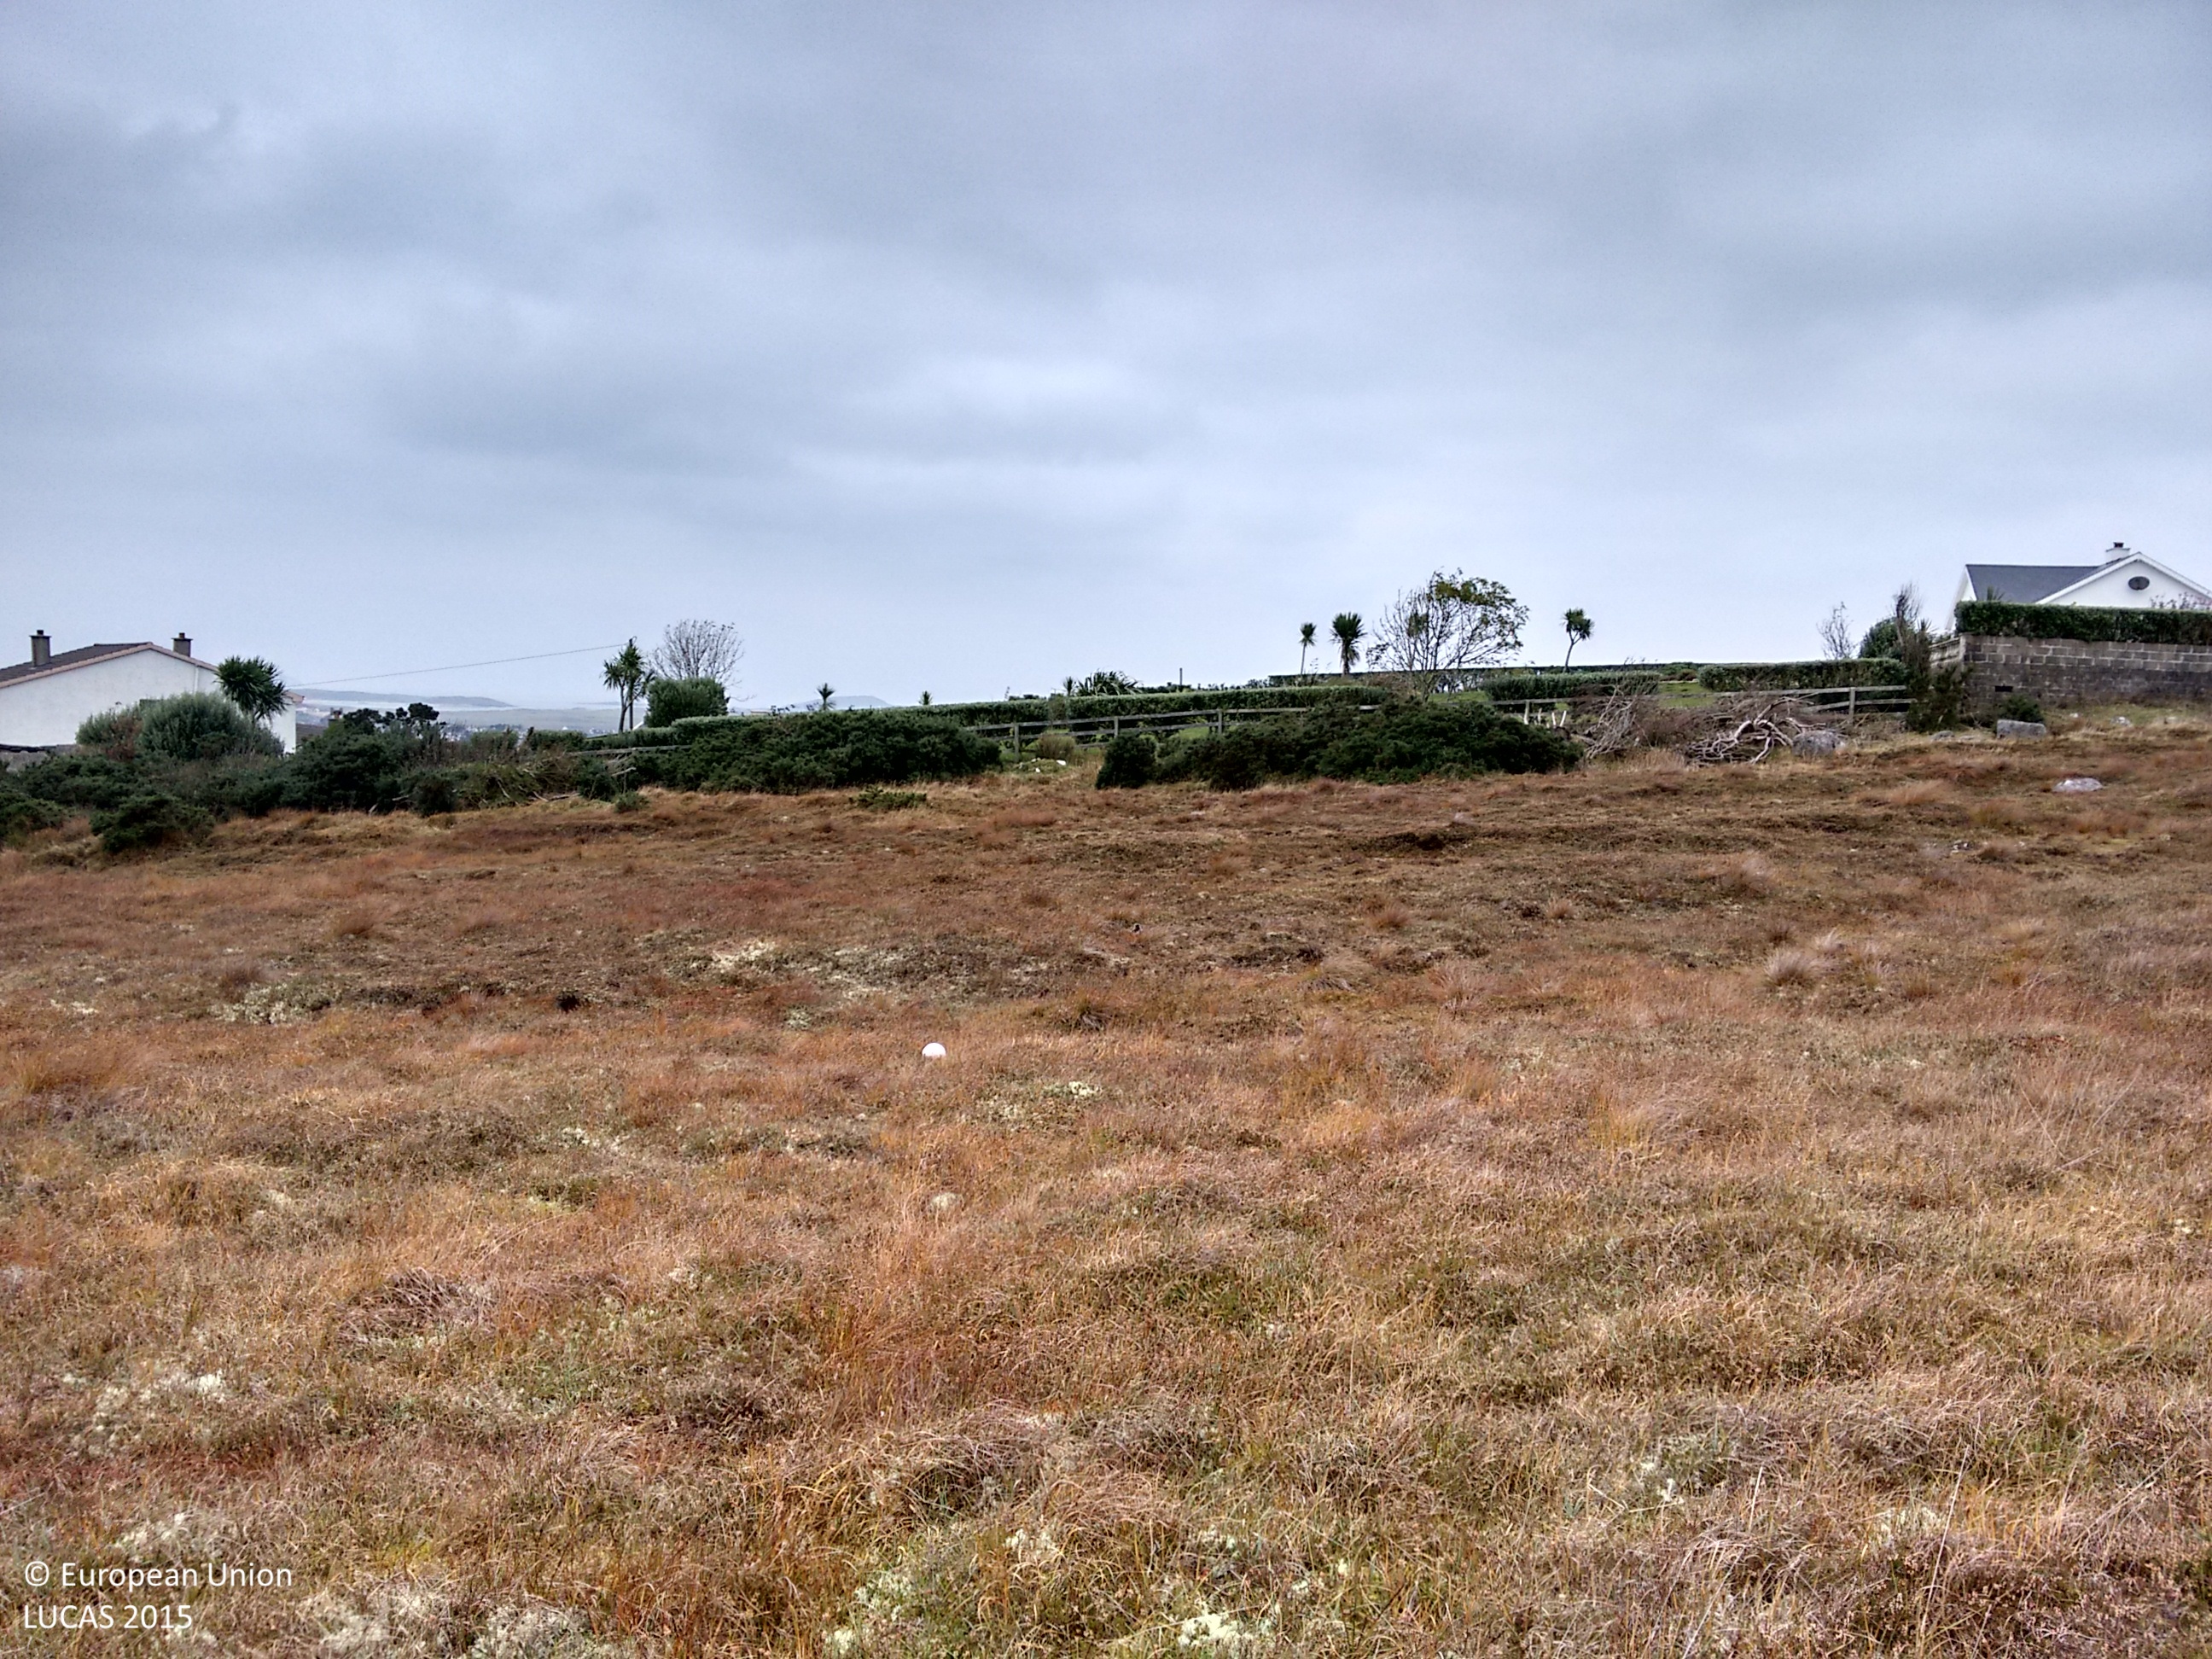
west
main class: Shrubland
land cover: Shrubland without tree cover
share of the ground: > 75 %
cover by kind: shrubs 40 %, herbaceous plants 40 %, lichens and mosses 20 %
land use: Agriculture (excluding fallow land and kitchen gardens)
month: November
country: IE
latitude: 55.0797
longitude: -8.2728
